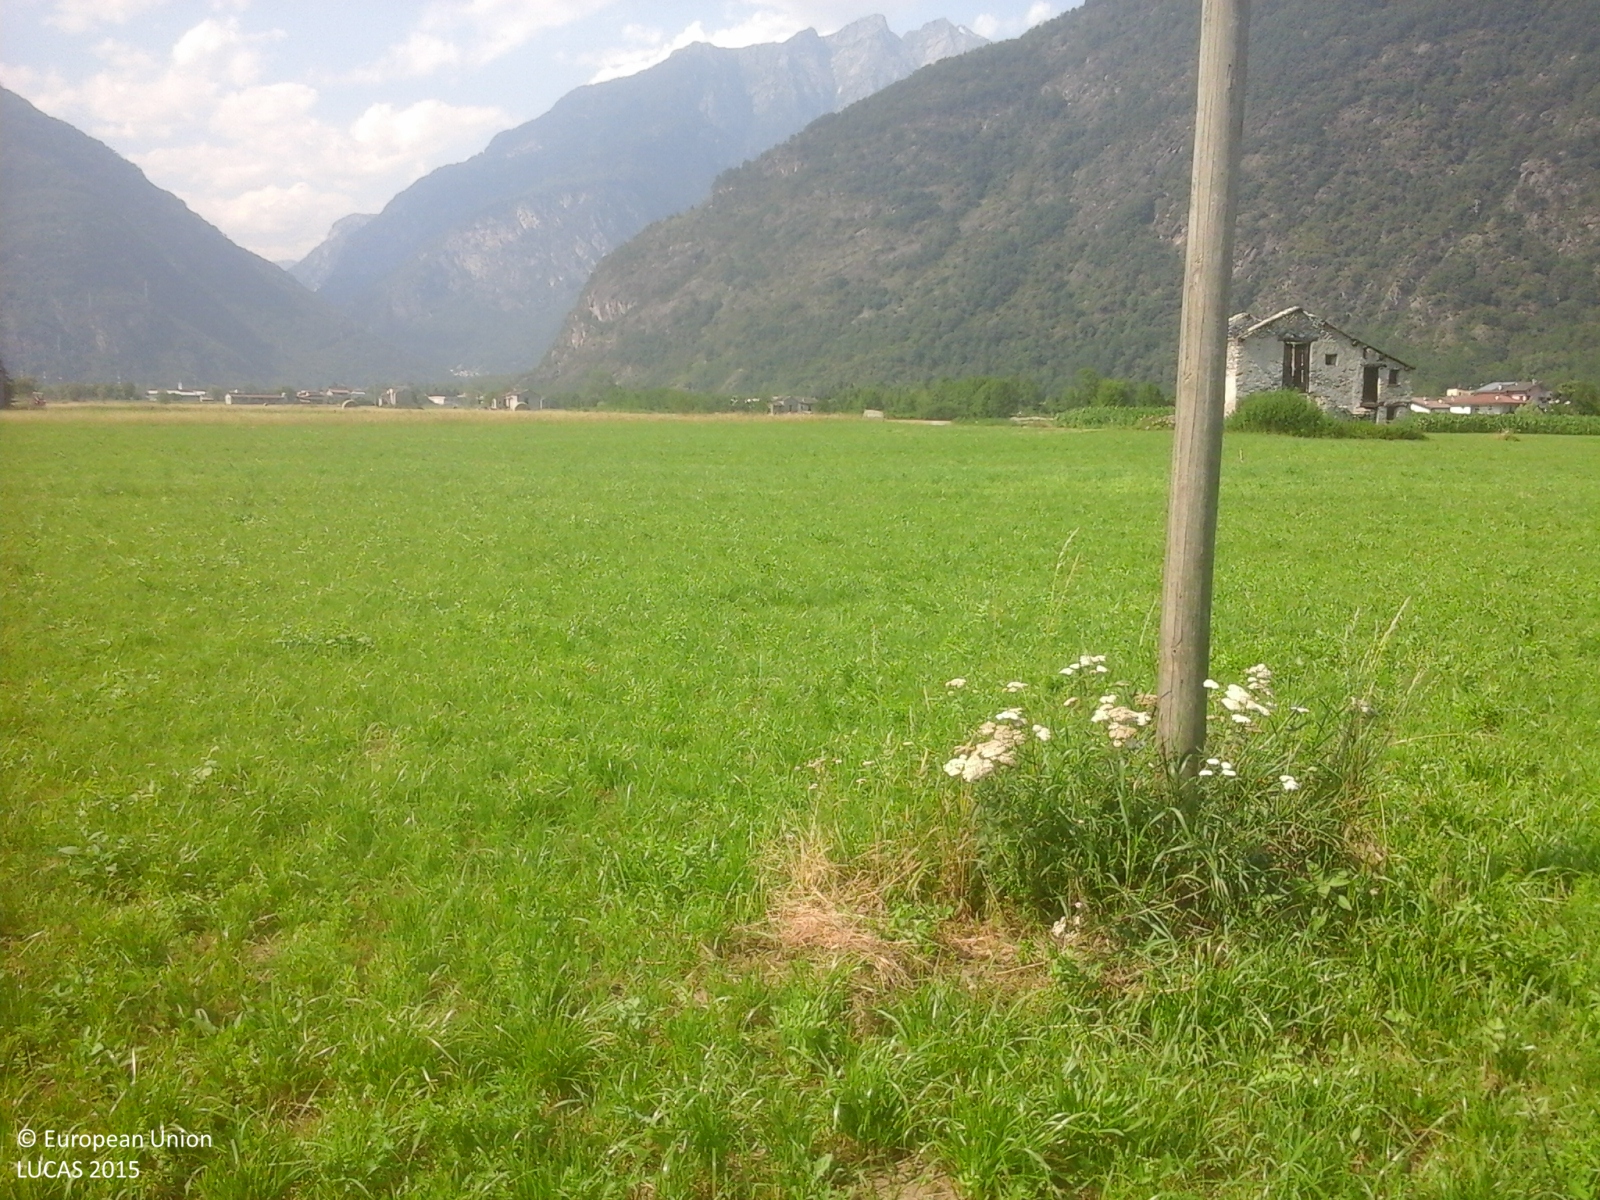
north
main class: Grassland
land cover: Grassland without tree/shrub cover
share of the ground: > 75 %
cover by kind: herbaceous plants 100 %
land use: Agriculture (excluding fallow land and kitchen gardens)
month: July
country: IT
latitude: 46.2774
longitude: 9.3909
